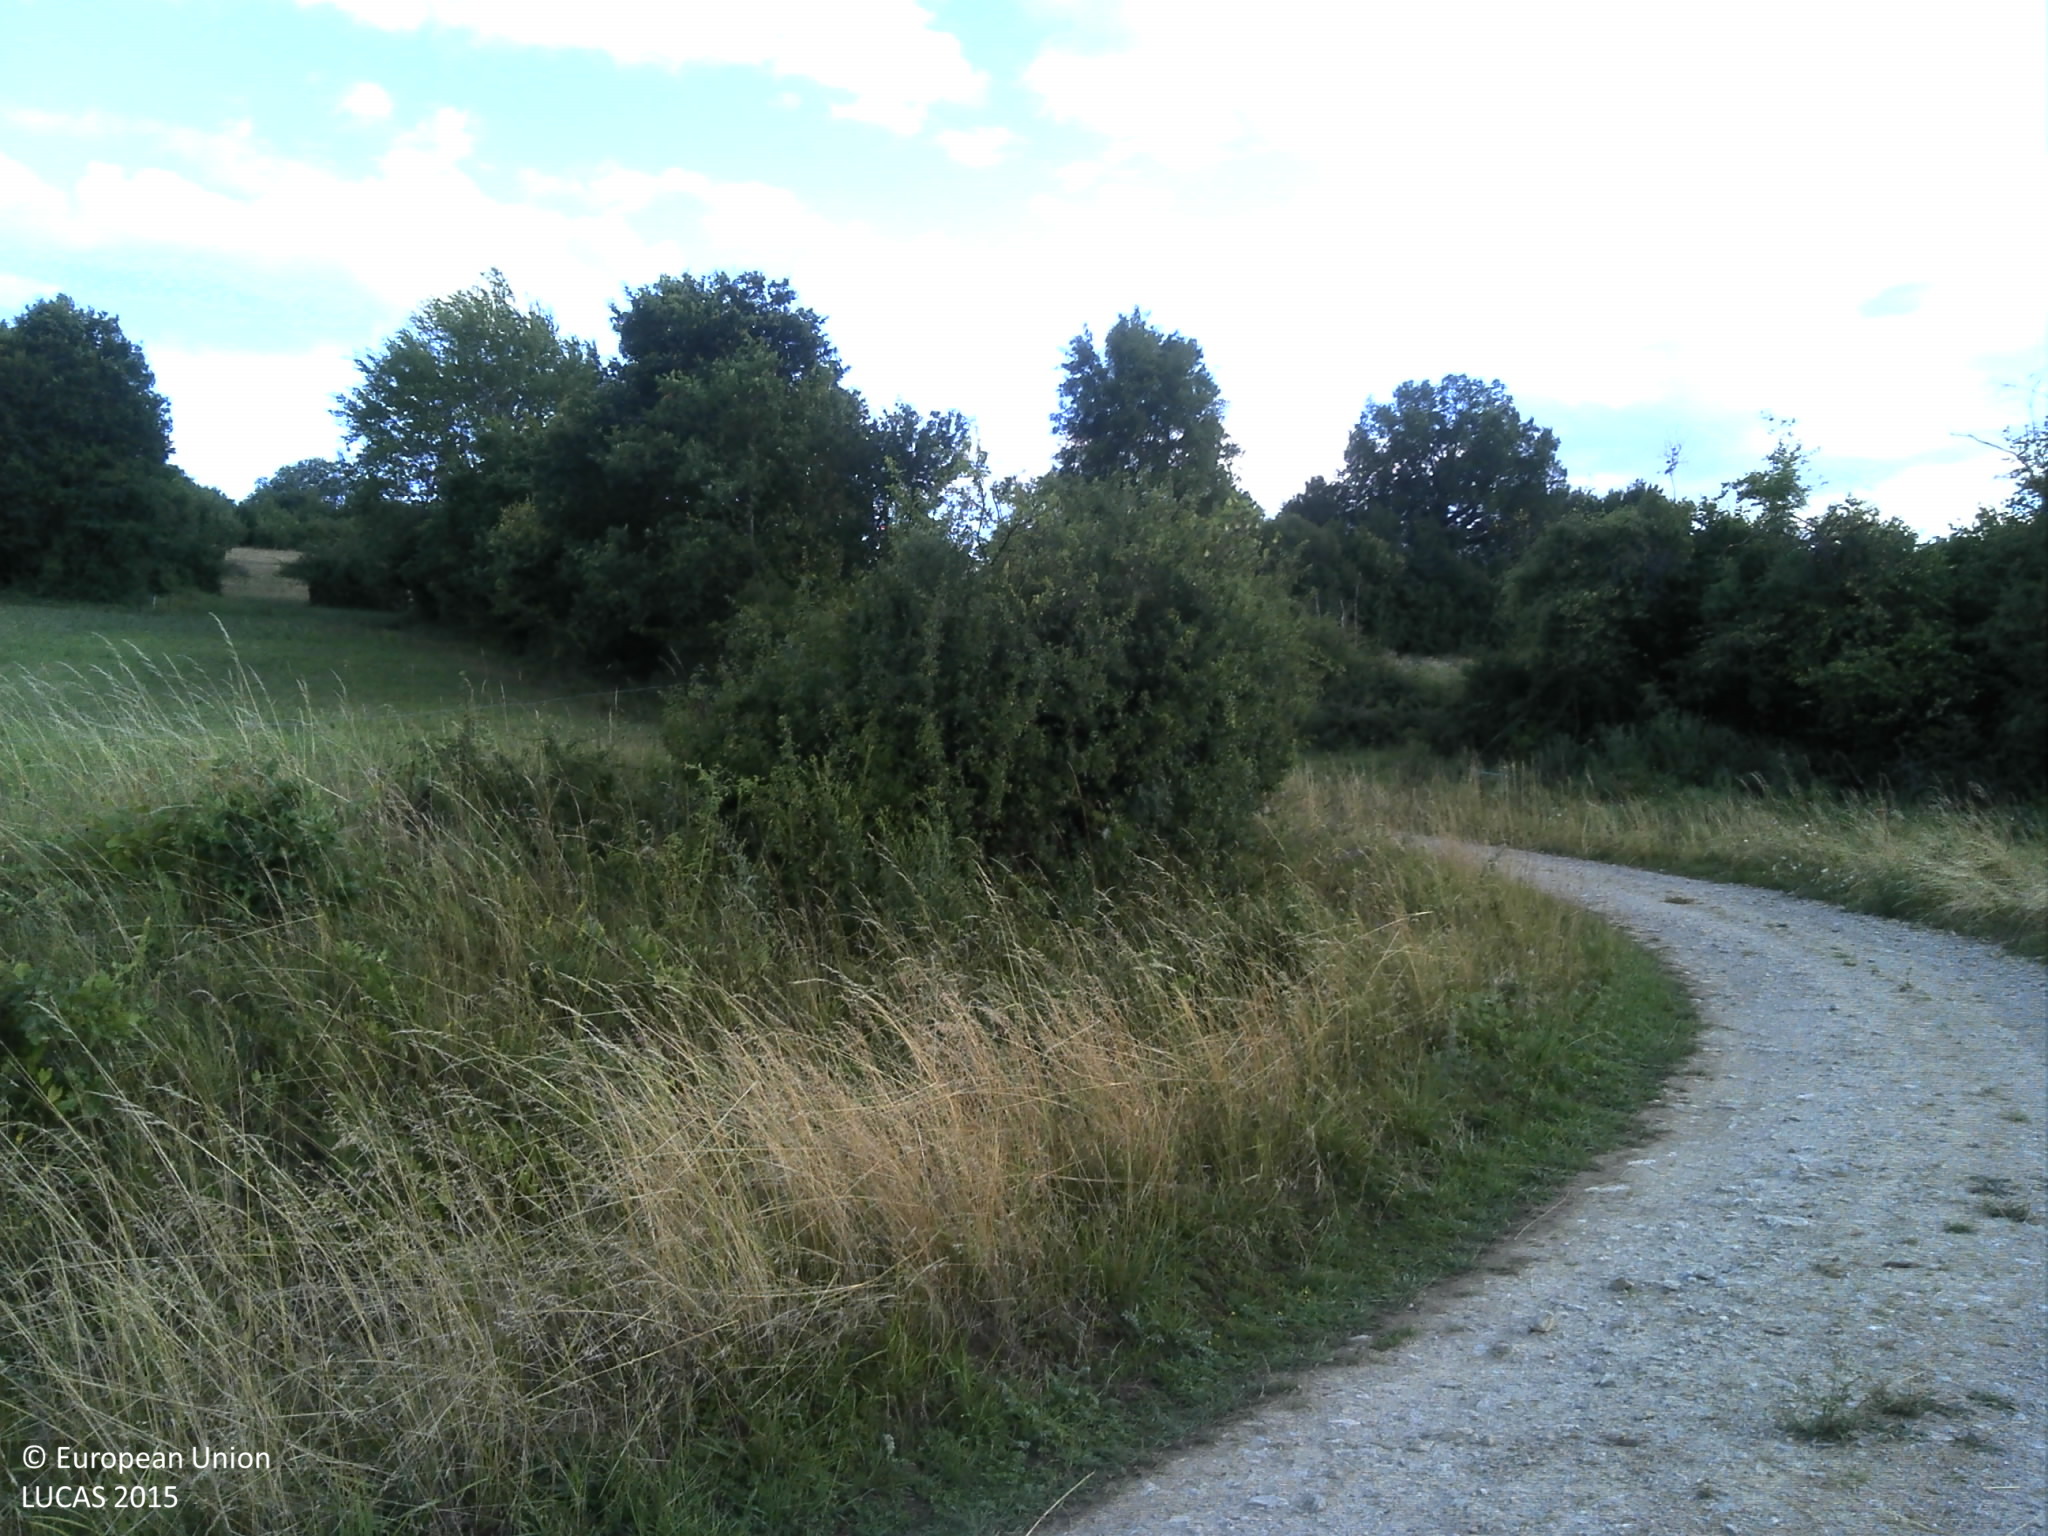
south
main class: Grassland
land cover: Grassland without tree/shrub cover
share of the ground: > 75 %
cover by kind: herbaceous plants 100 %
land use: Agriculture (excluding fallow land and kitchen gardens)
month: July
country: FR
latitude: 49.0582
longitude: 6.7570
